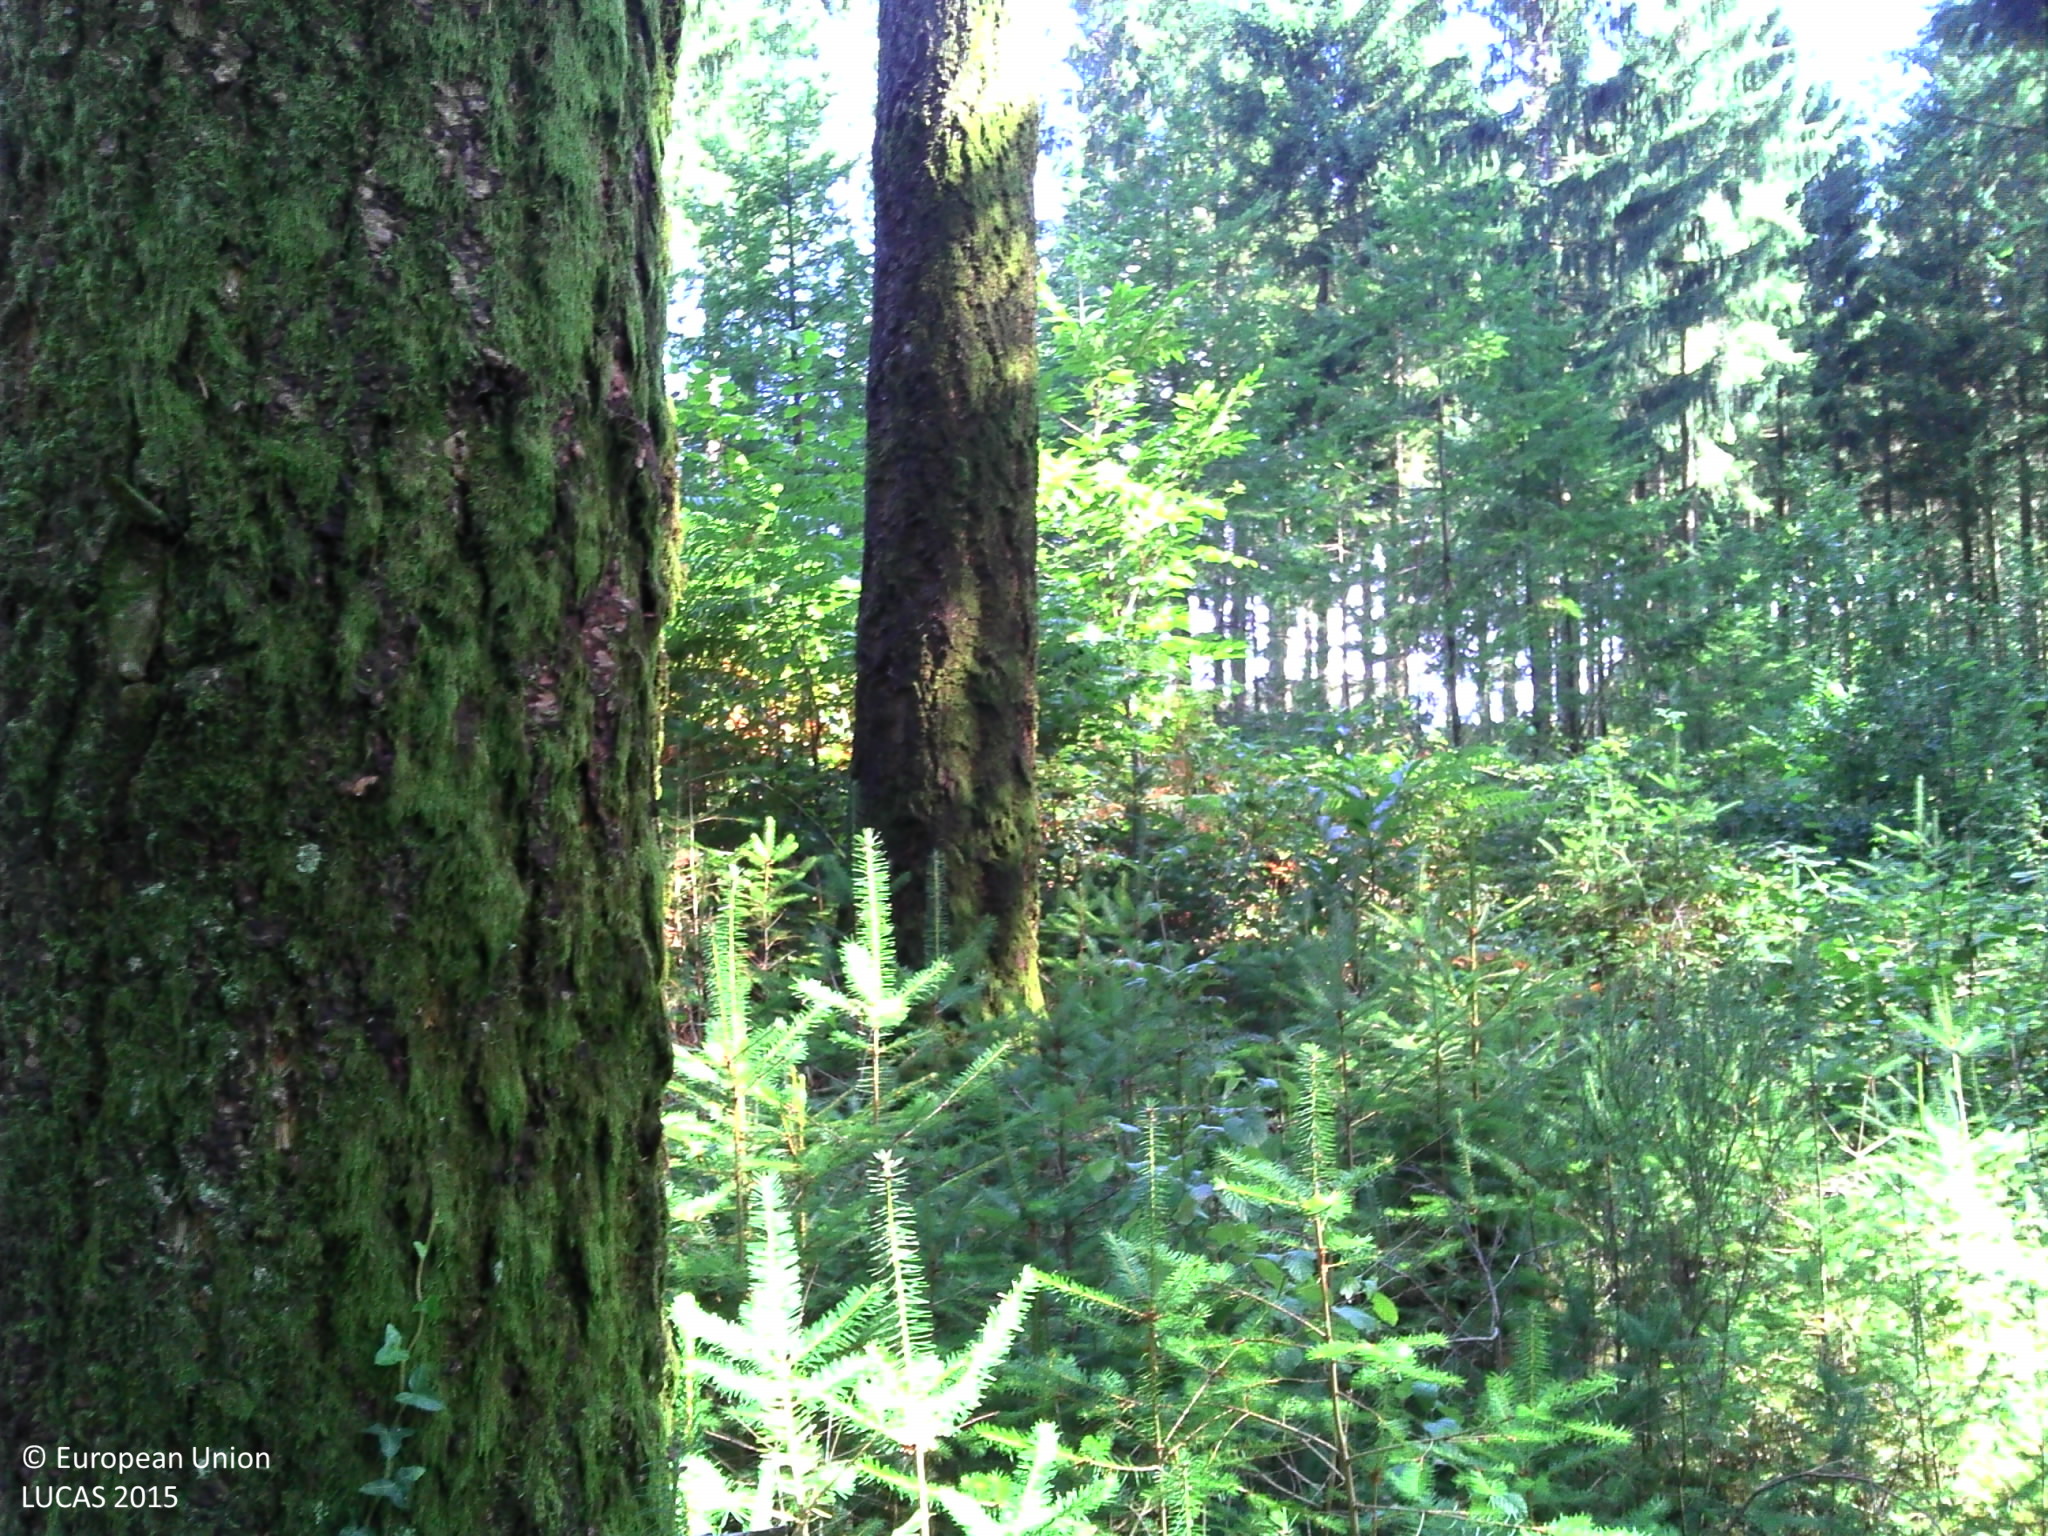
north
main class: Woodland
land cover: Other coniferous woodland
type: exotic forest
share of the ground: > 75 %
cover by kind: coniferous forest trees 65 %, herbaceous plants 35 %
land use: Forestry
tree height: > 5 m
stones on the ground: < 10 %
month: August
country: FR
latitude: 45.6554
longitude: 1.7943
